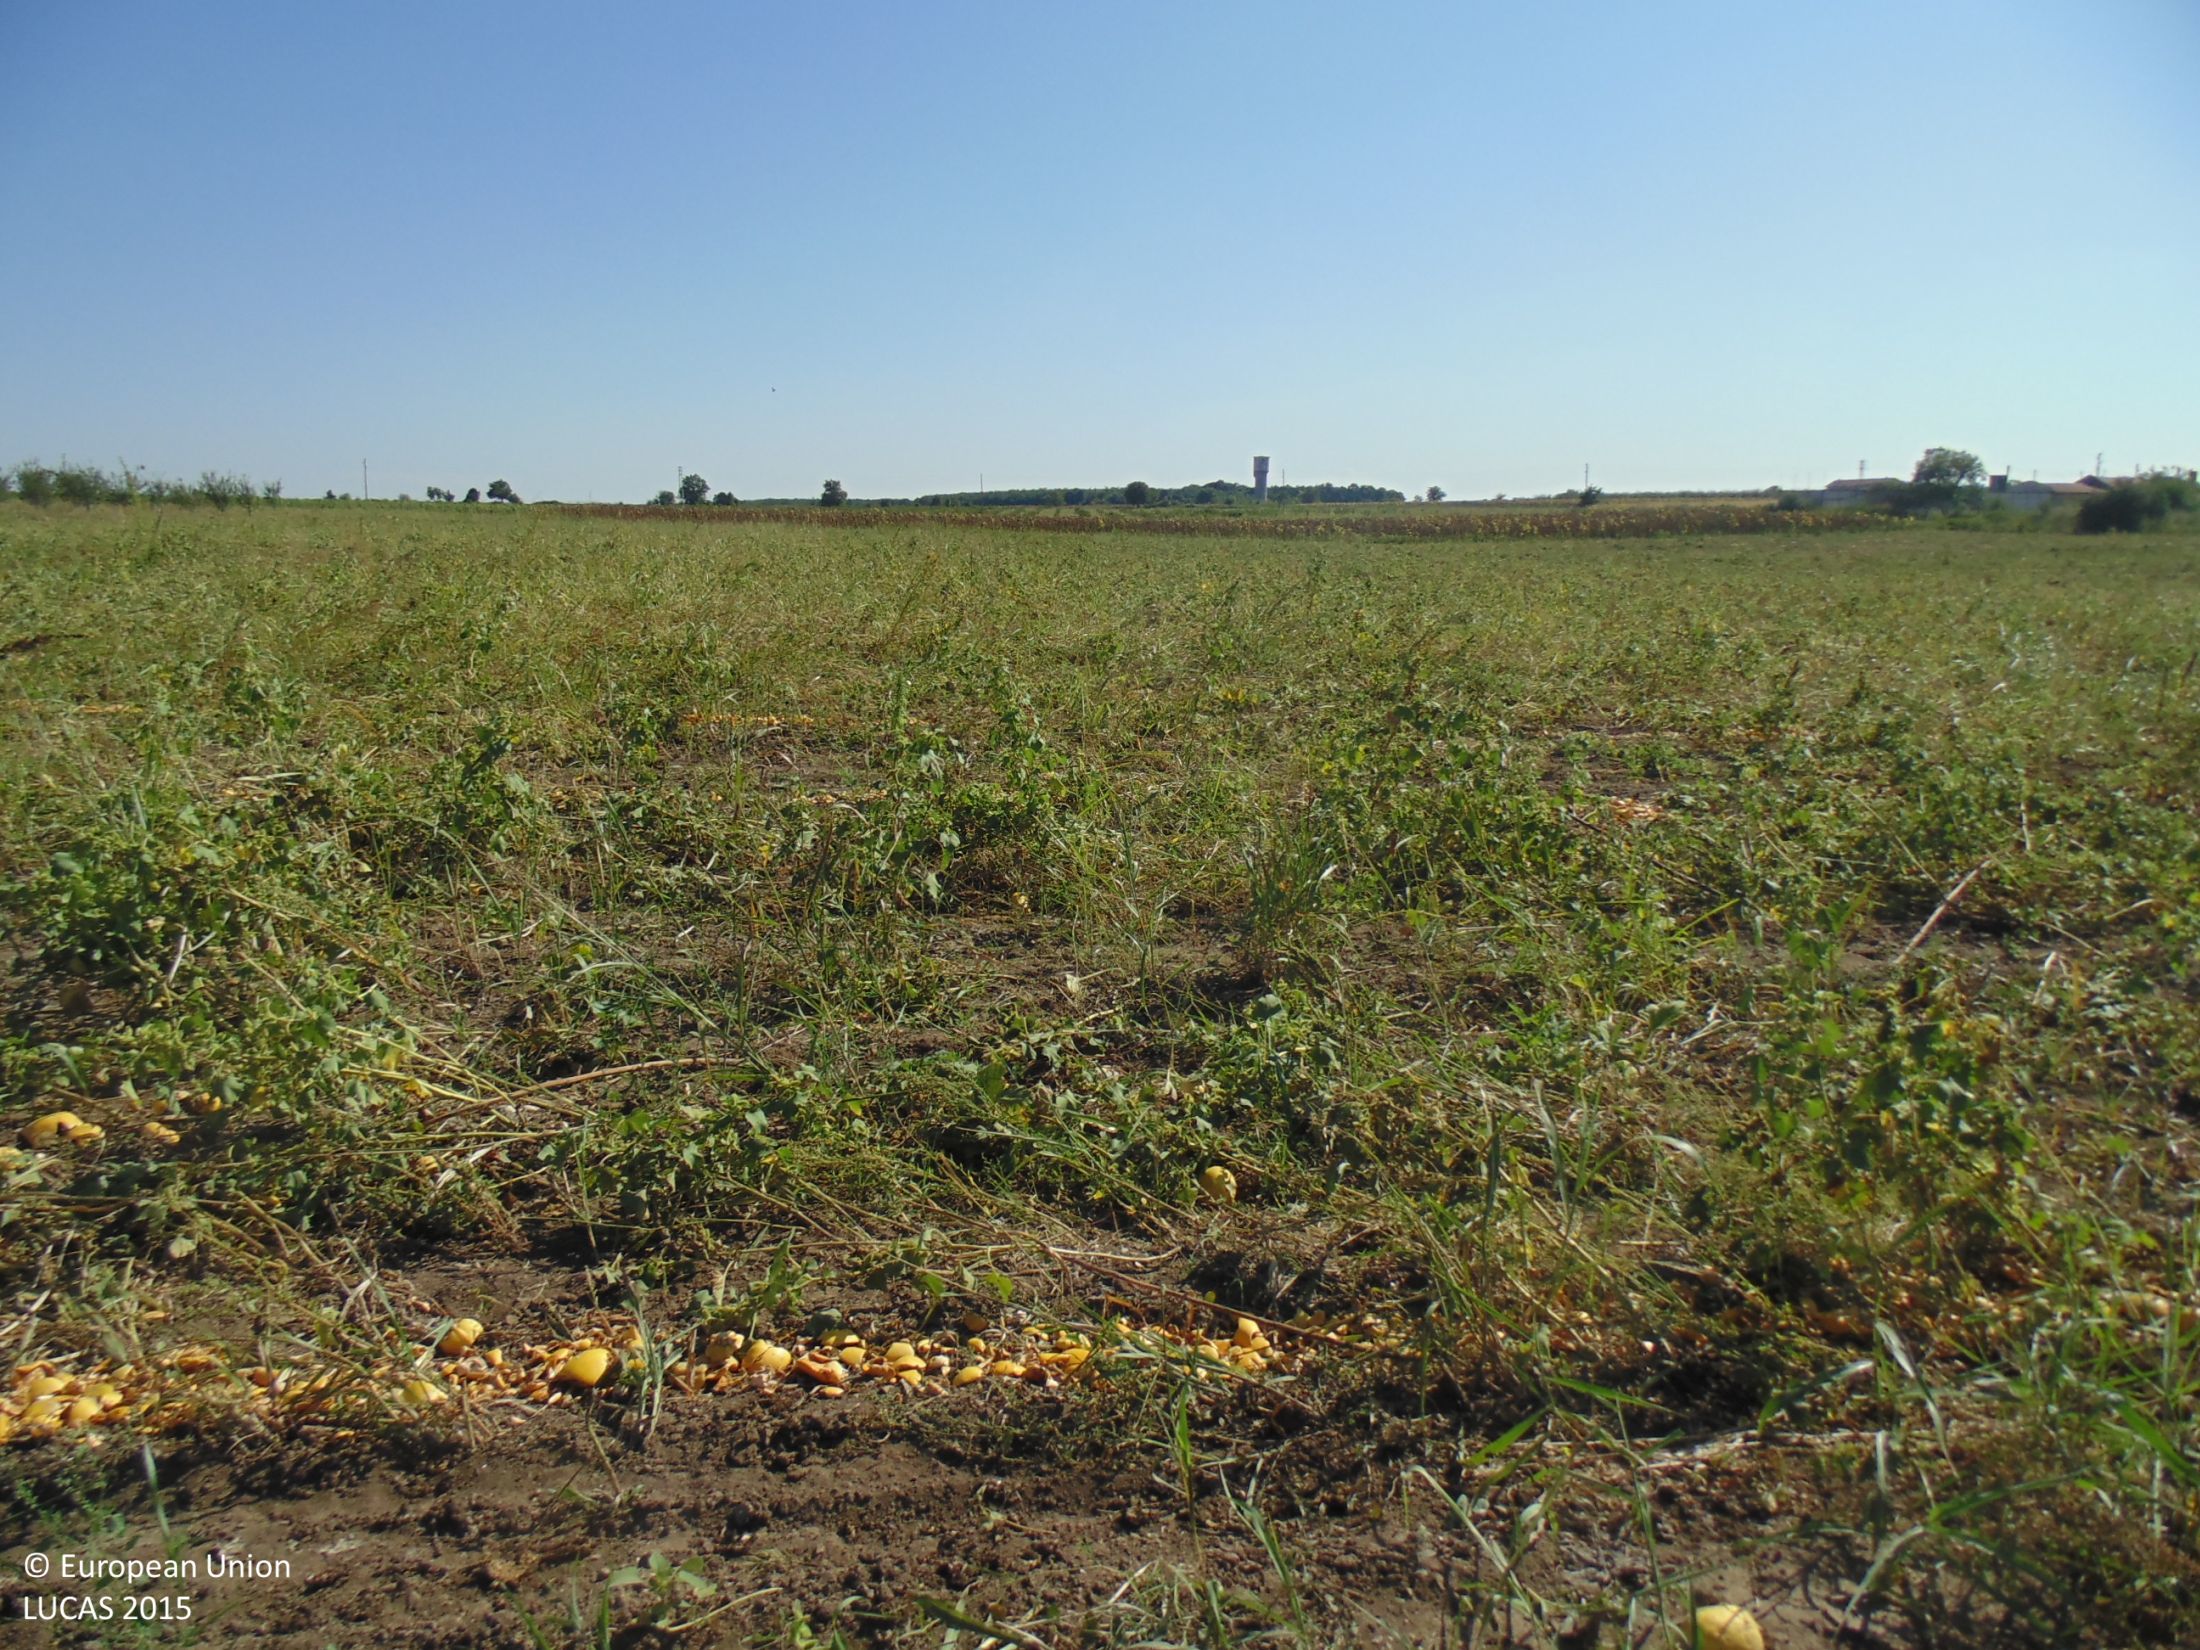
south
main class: Cropland
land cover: Other fresh vegetables
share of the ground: 10 - 25 %
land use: Agriculture (excluding fallow land and kitchen gardens)
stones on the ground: < 10 %
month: September
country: BG
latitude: 43.8804
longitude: 26.9601
